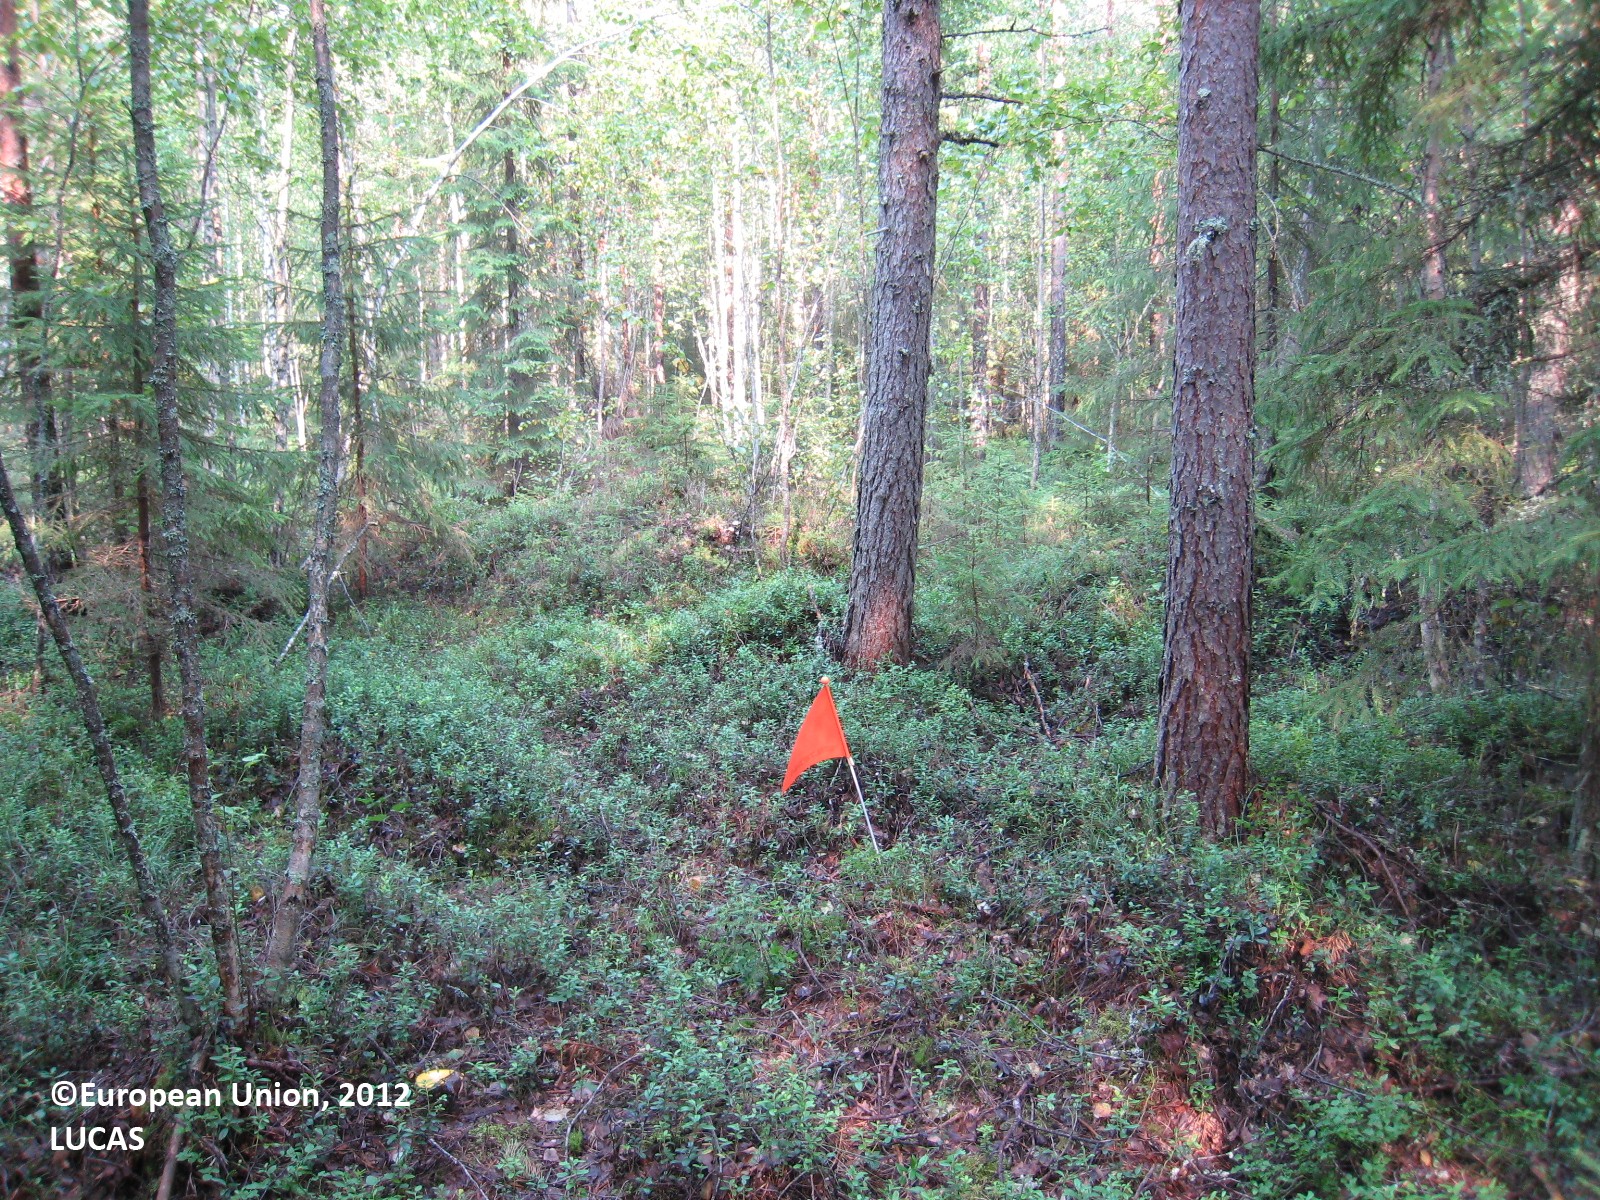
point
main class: Woodland
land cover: Other mixed woodland
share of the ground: > 75 %
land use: Forestry
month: July
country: FI
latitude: 62.4328
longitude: 27.3034
